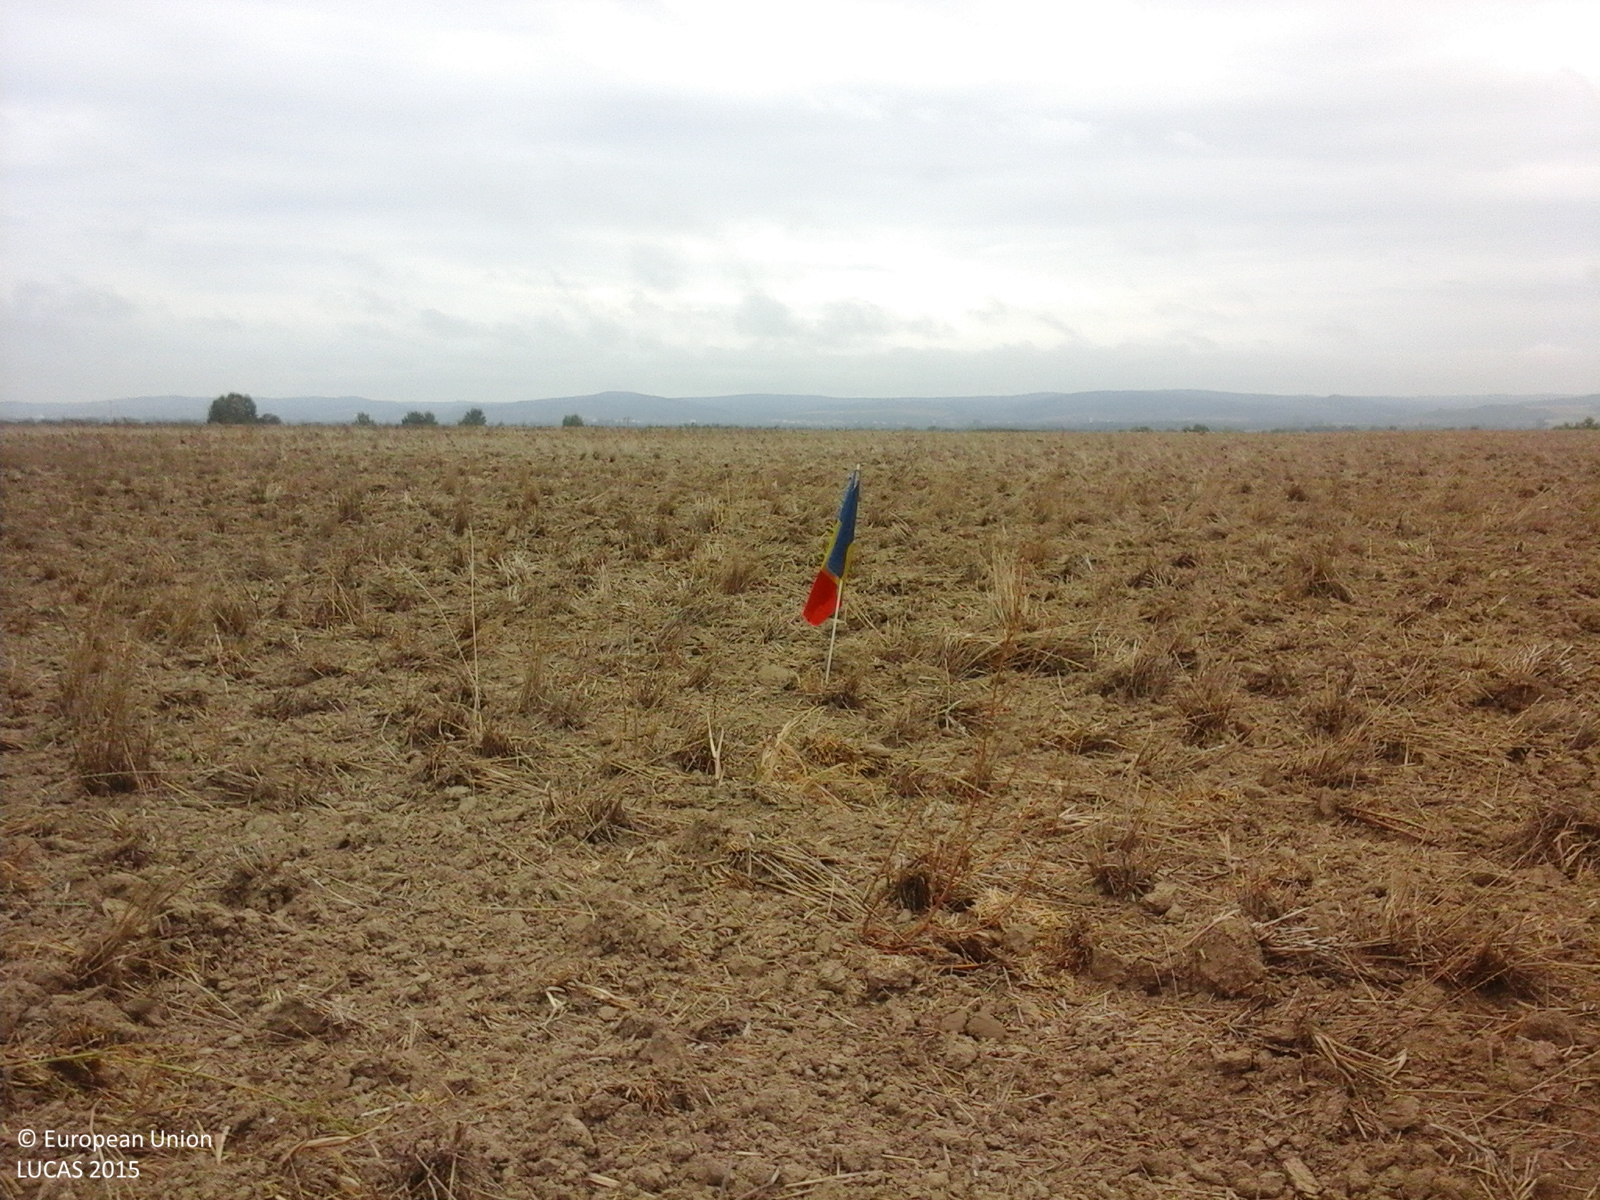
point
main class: Cropland
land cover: Common wheat
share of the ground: < 10 %
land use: Agriculture (excluding fallow land and kitchen gardens)
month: September
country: RO
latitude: 45.6207
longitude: 21.9791
